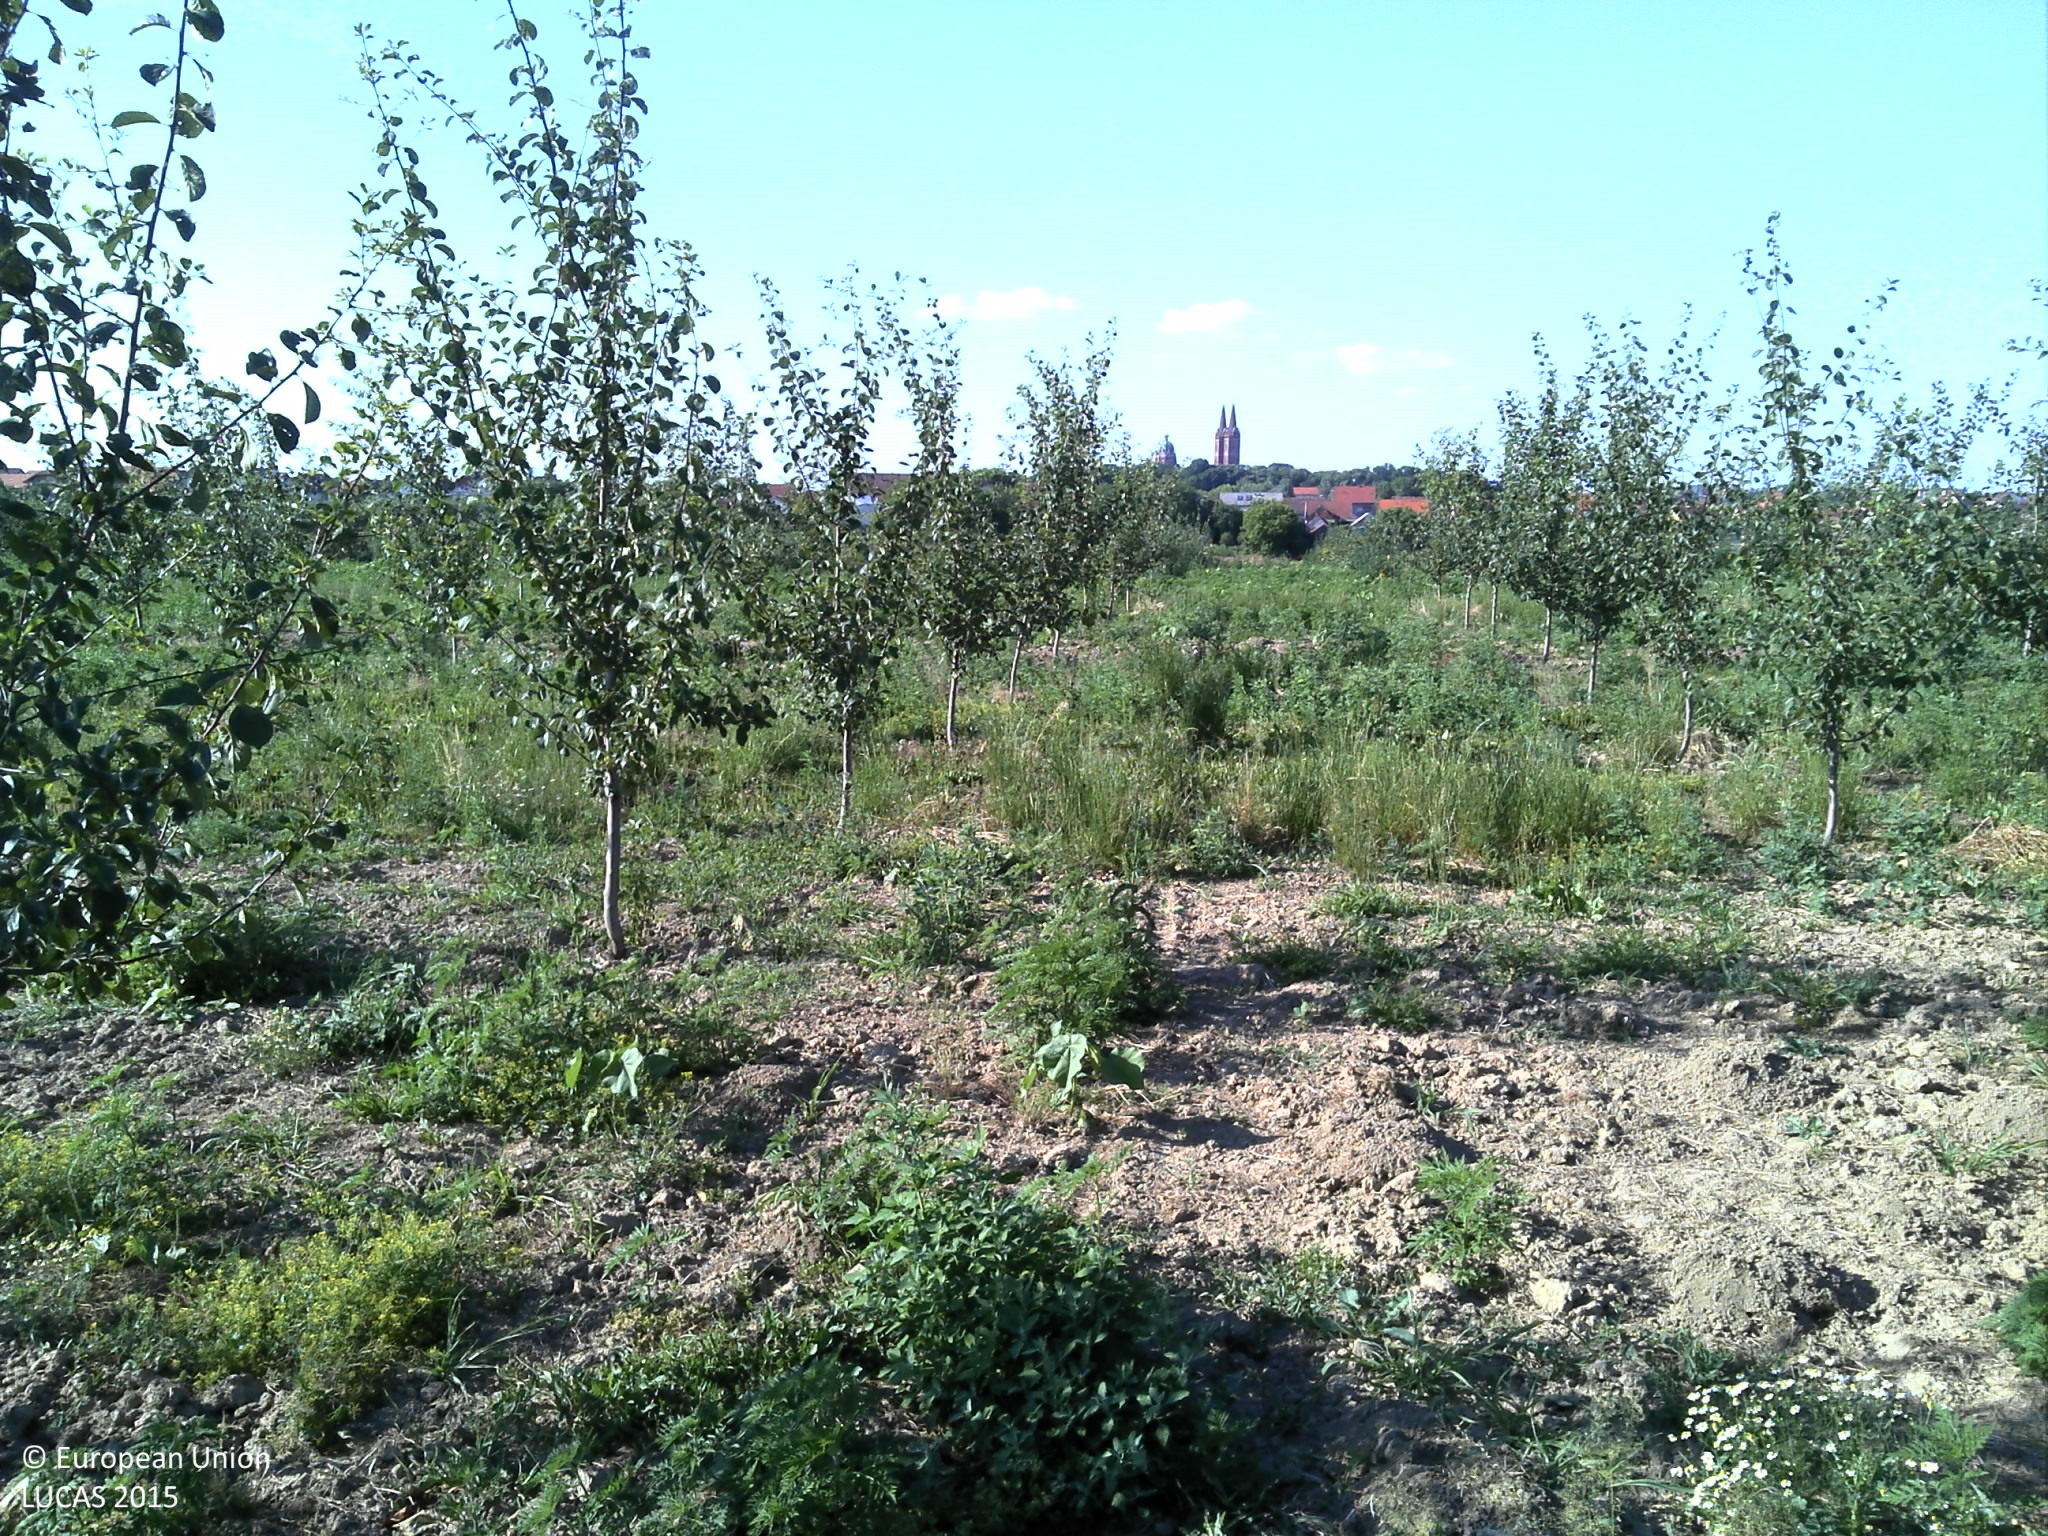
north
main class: Cropland
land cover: Other fruit trees and berries
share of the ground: 10 - 25 %
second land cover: Spontaneously vegetated surfaces
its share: 25 - 50 %
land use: Agriculture (excluding fallow land and kitchen gardens)
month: July
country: HR
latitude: 45.2953
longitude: 18.4082
